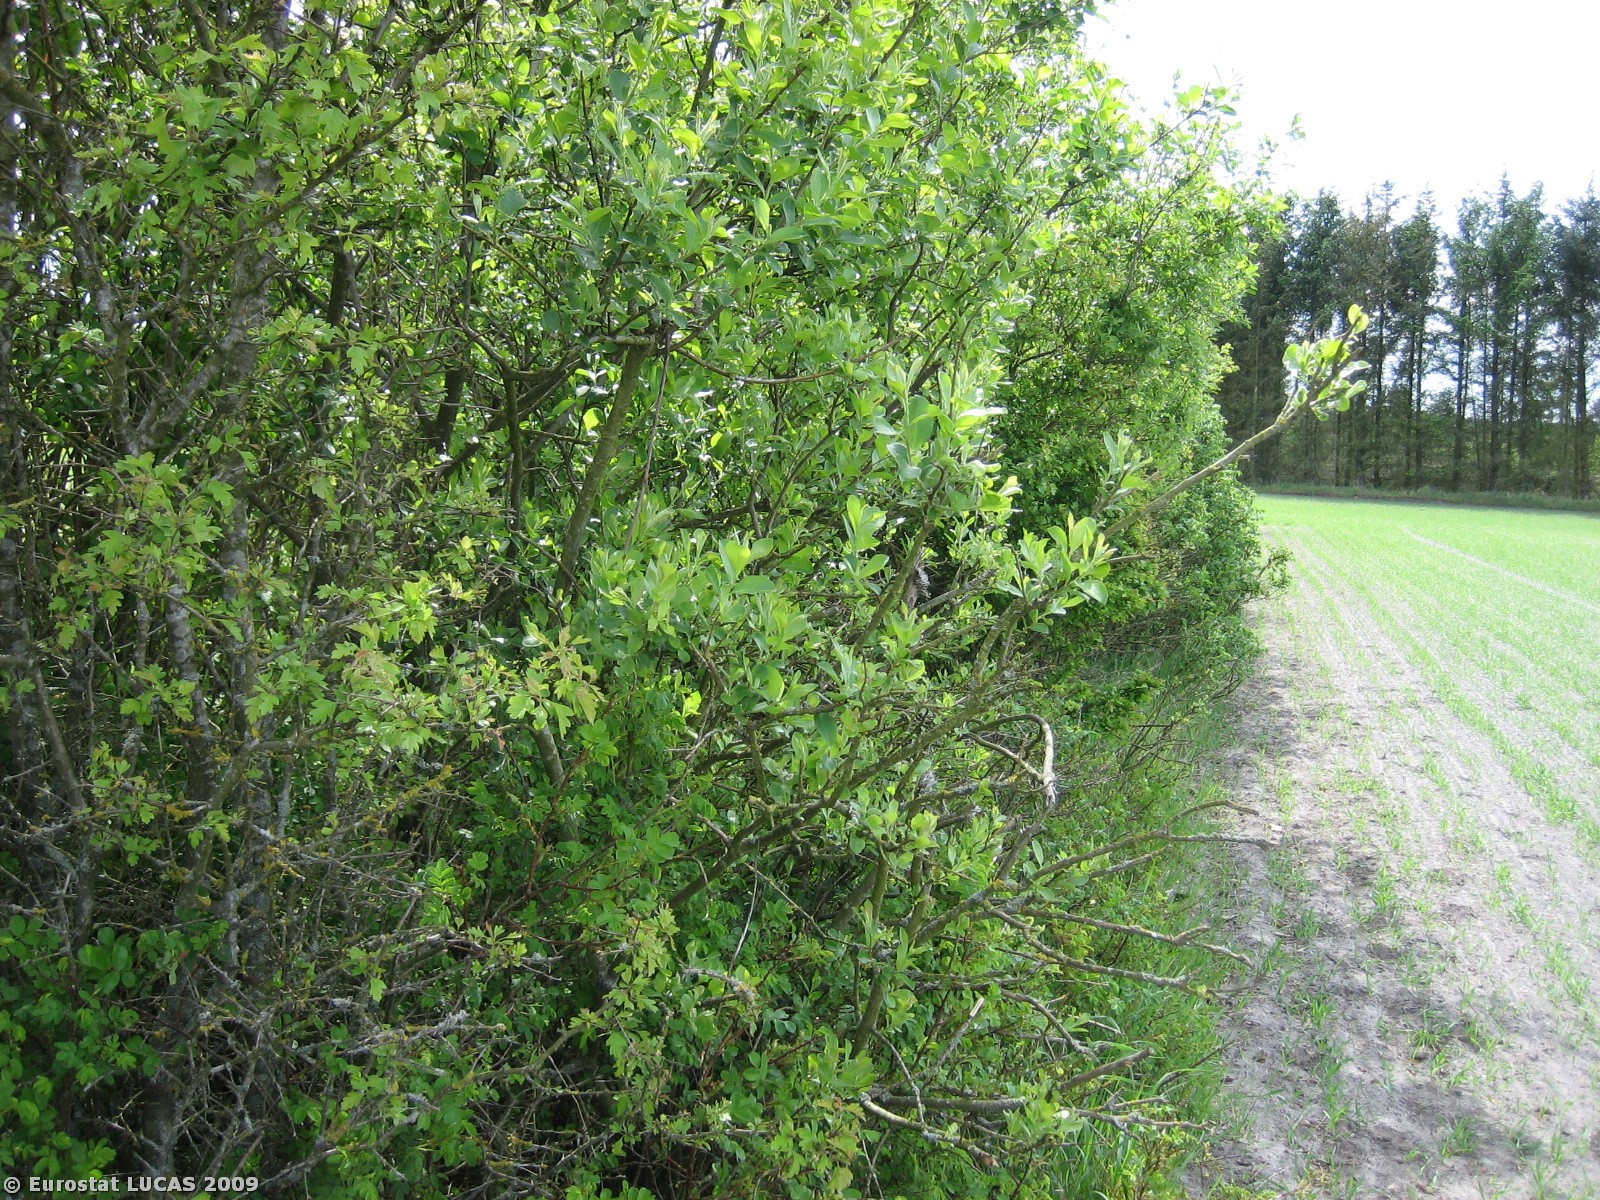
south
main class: Shrubland
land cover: Shrubland with sparse tree cover
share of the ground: > 75 %
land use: Unused
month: May
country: DK
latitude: 56.1958
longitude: 8.4062
